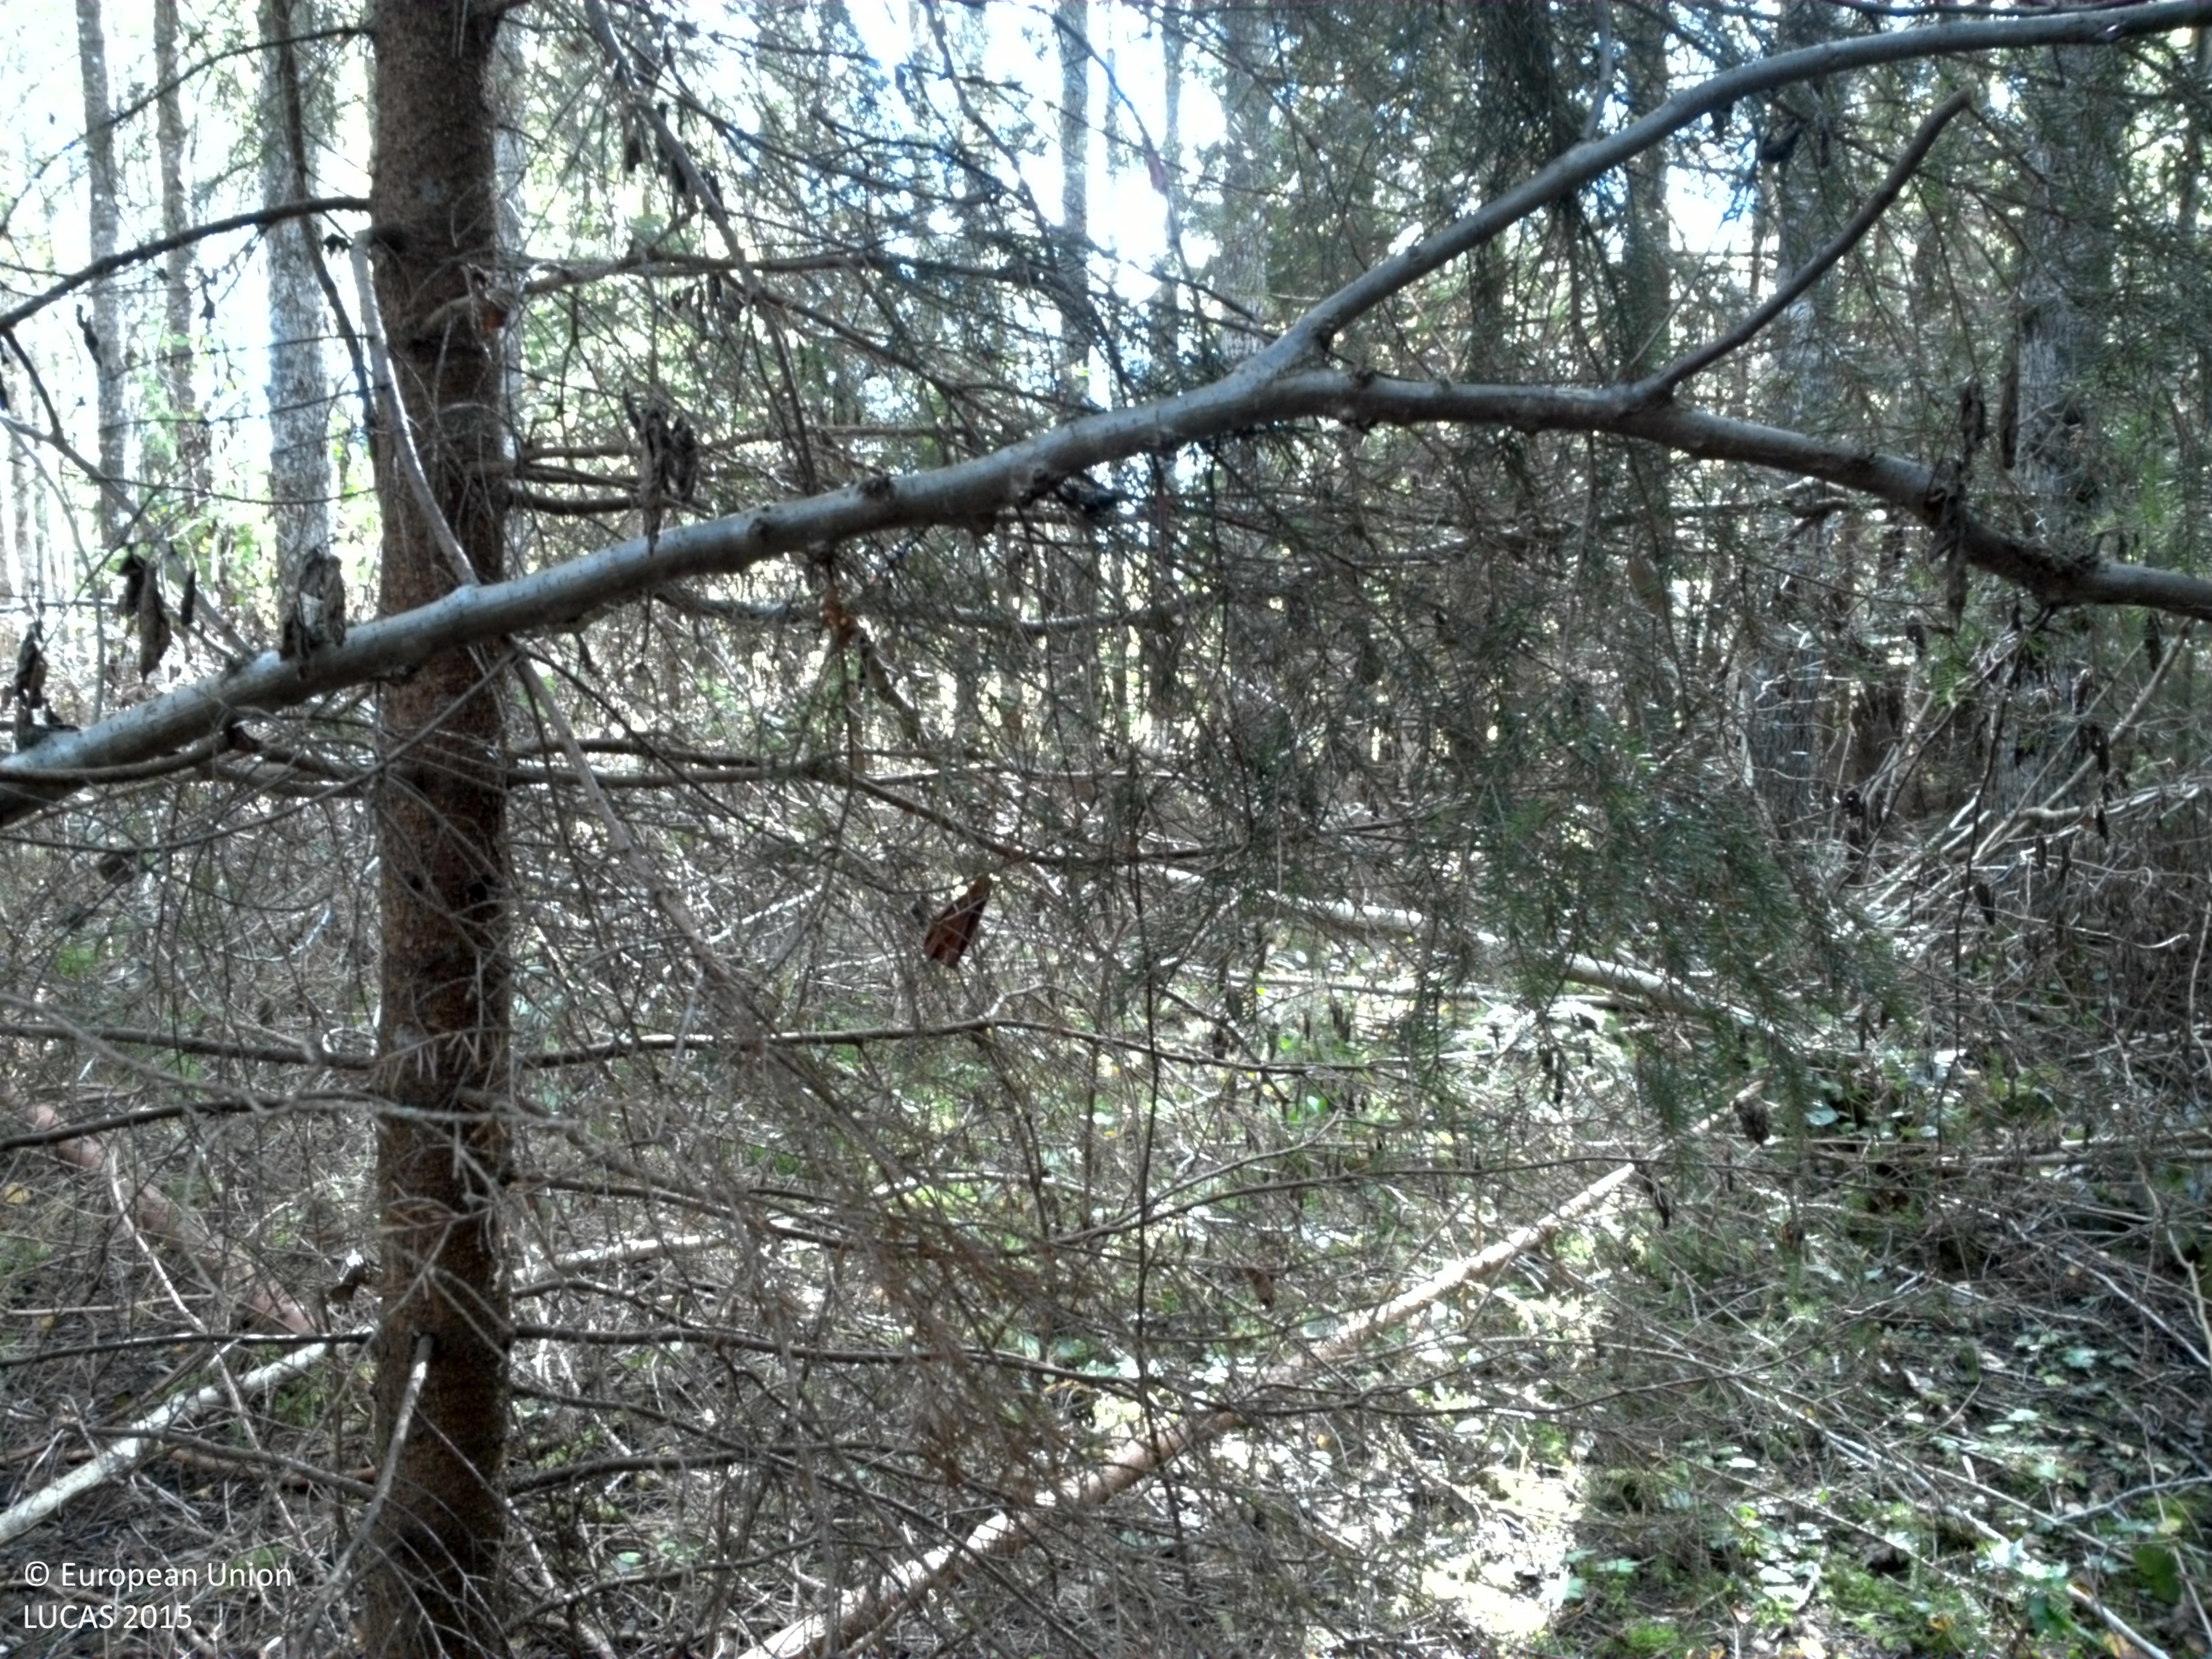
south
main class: Woodland
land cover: Broadleaved woodland
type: hemiboreal forest and nemoral coniferous forest and mixed broadleaved-coniferous forest
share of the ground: > 75 %
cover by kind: broadleaved forest trees 70 %, coniferous forest trees 10 %, lichens and mosses 10 %, unconsolidated bare surface 10 %
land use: Forestry
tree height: > 5 m
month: September
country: SE
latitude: 59.8844
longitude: 18.8448
